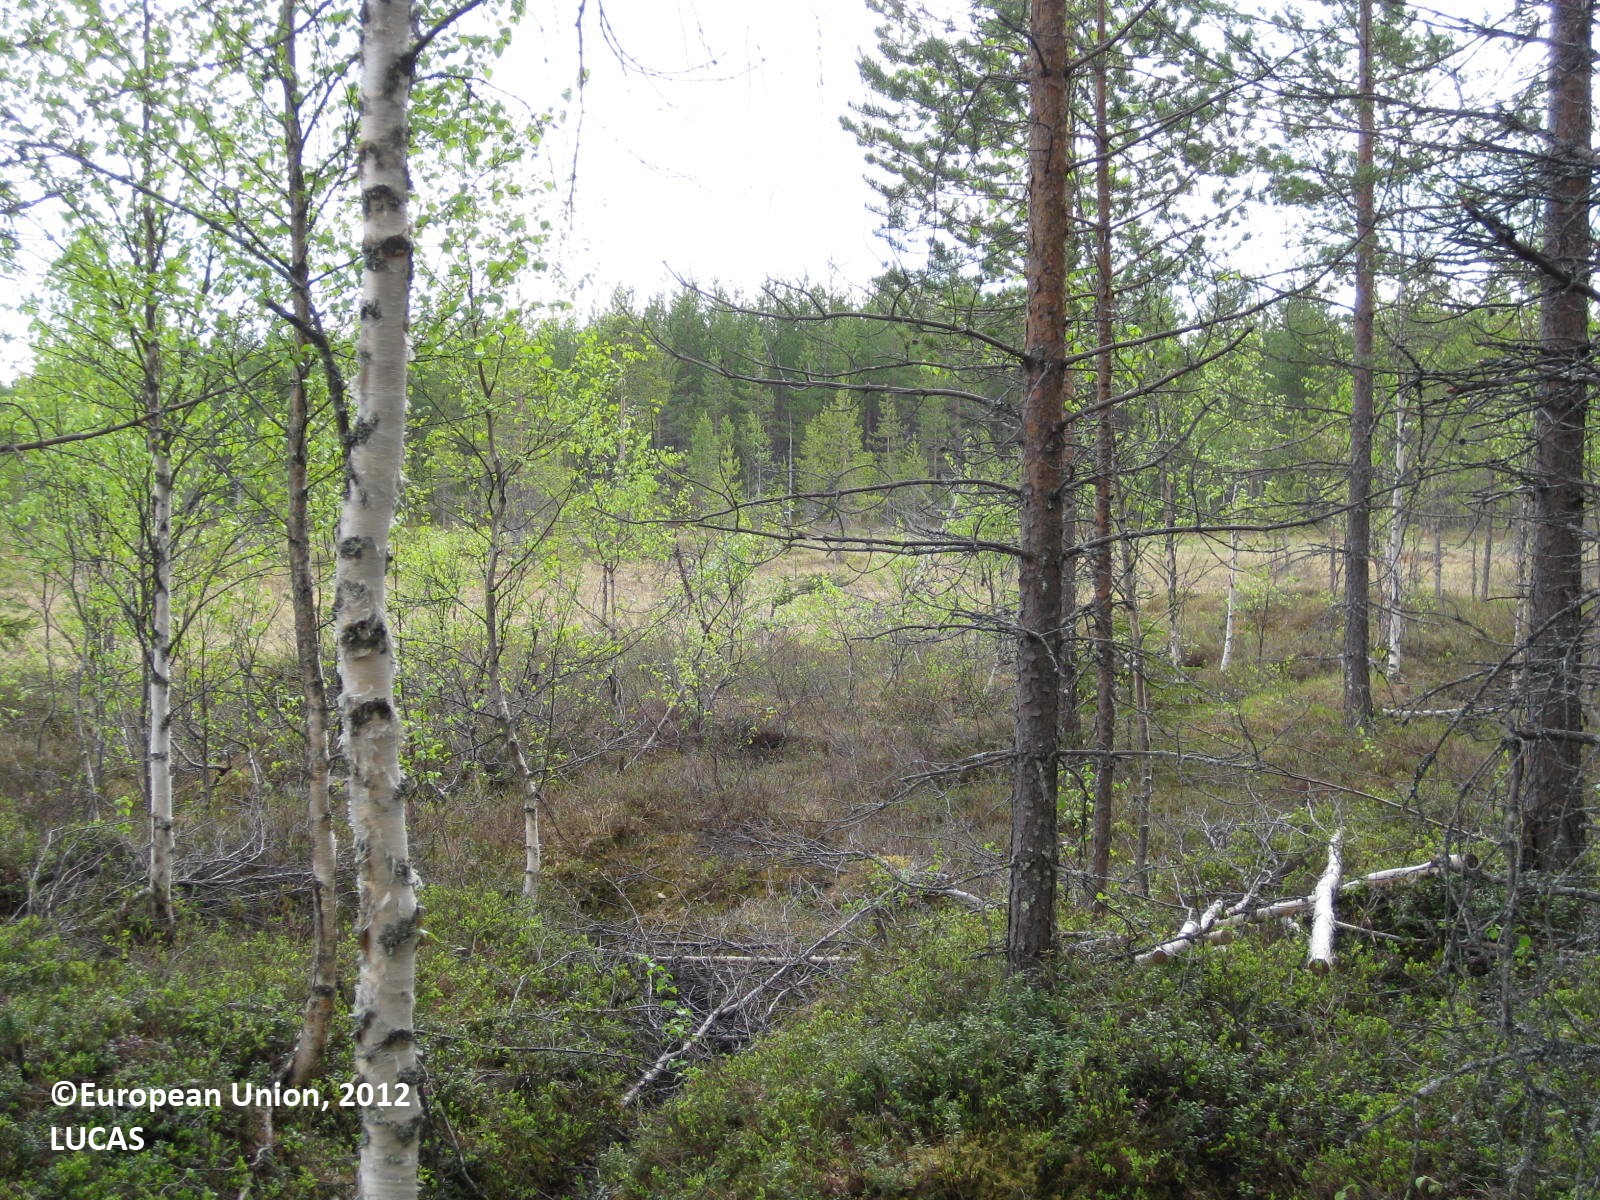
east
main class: Woodland
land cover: Pine dominated mixed woodland
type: boreal forest
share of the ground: > 75 %
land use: Forestry
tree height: > 5 m
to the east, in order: Pine dominated mixed woodland; Ditches and canals; Pine dominated mixed woodland; Peatbogs; Pine dominated coniferous woodland; Ditches and canals; Pine dominated mixed woodland; Ditches and canals; Pine dominated mixed woodland; Ditches and canals; Pine dominated mixed woodland; Pine dominated coniferous woodland
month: June
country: FI
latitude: 65.0195
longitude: 29.5407
